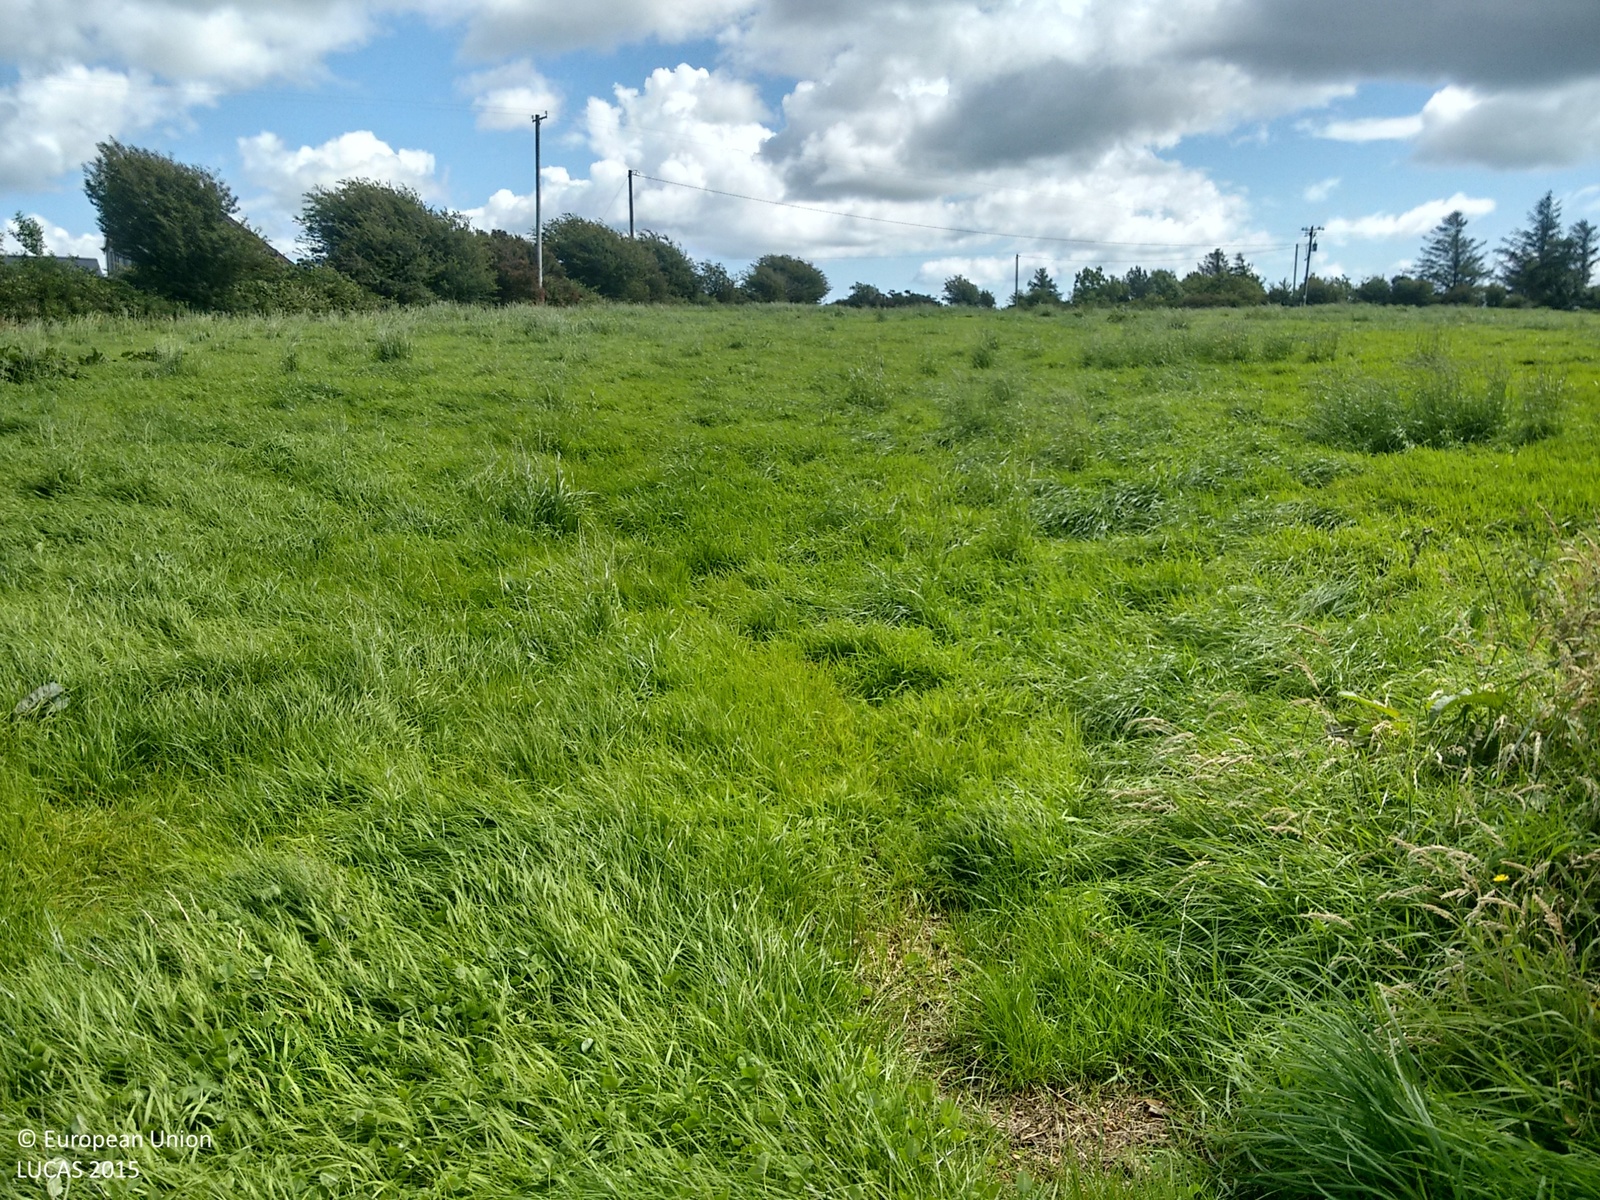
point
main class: Grassland
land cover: Grassland without tree/shrub cover
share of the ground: > 75 %
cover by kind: herbaceous plants 100 %
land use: Agriculture (excluding fallow land and kitchen gardens)
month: July
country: IE
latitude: 51.6185
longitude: -9.2138
